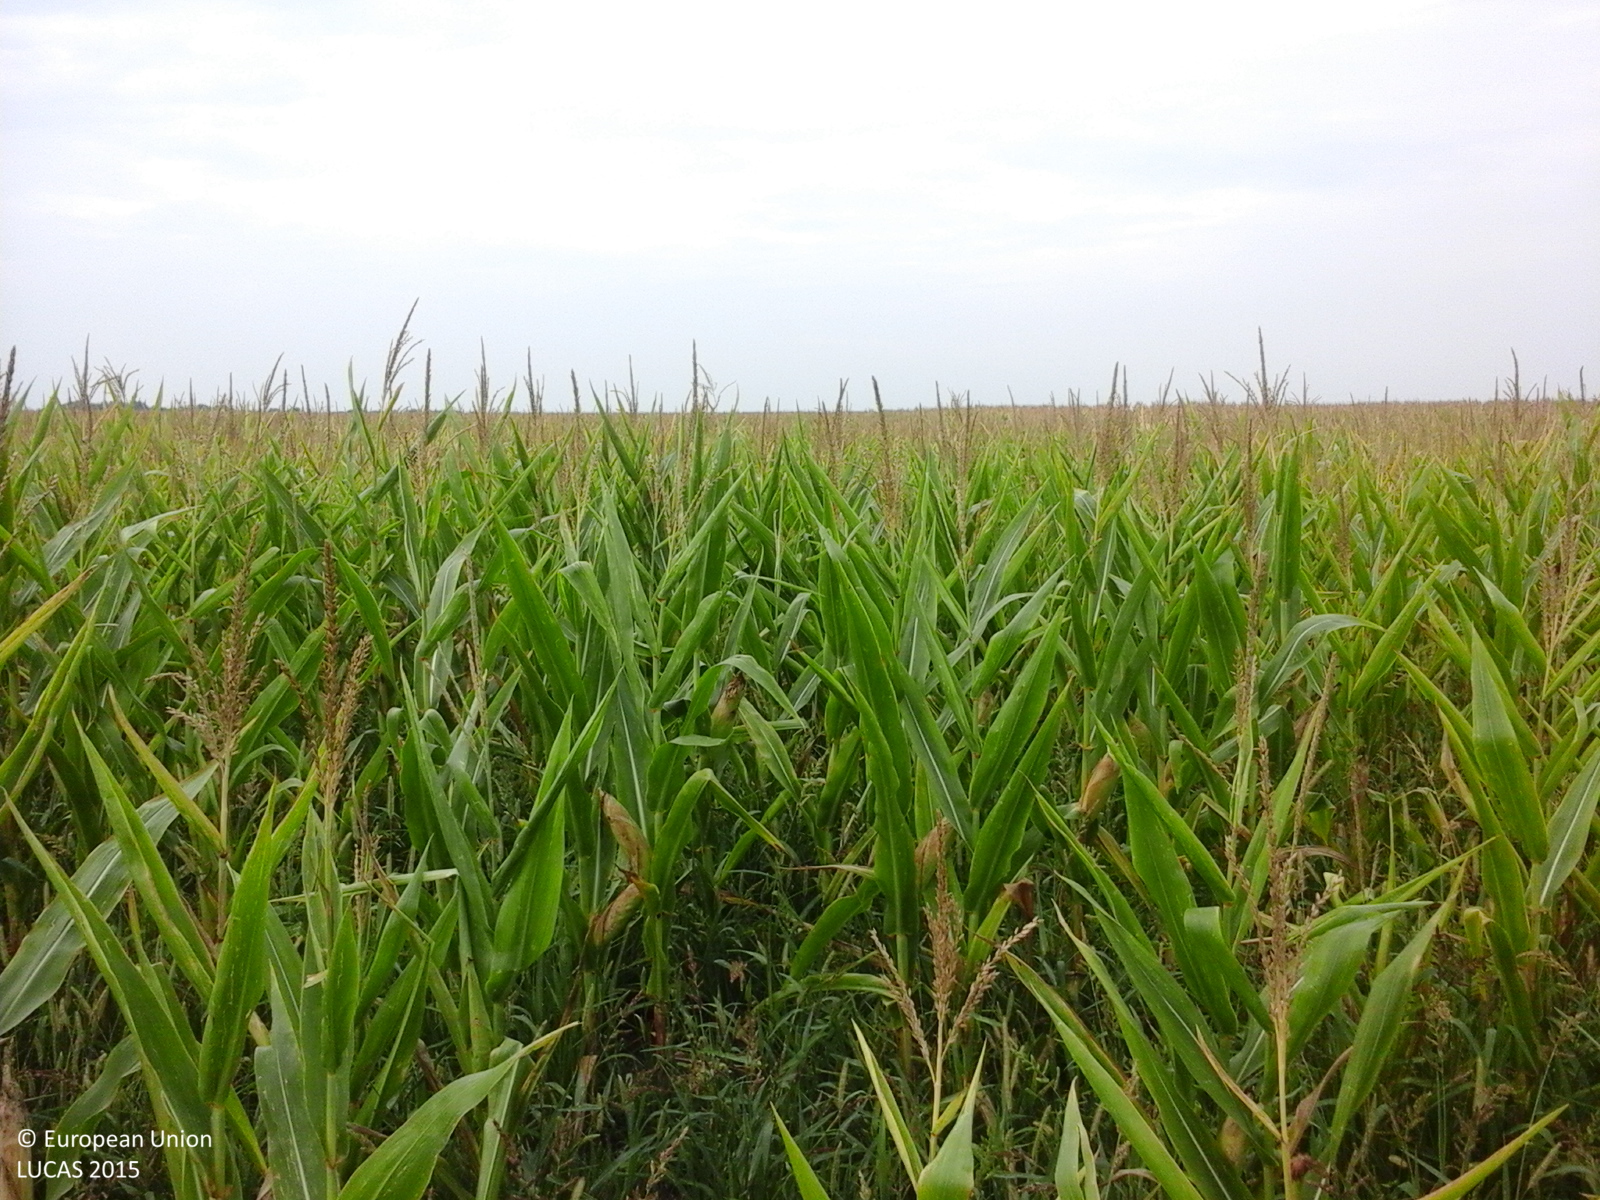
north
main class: Cropland
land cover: Maize
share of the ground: > 75 %
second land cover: Spontaneously vegetated surfaces
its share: > 75 %
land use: Agriculture (excluding fallow land and kitchen gardens)
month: August
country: RO
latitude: 46.2408
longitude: 21.3039
